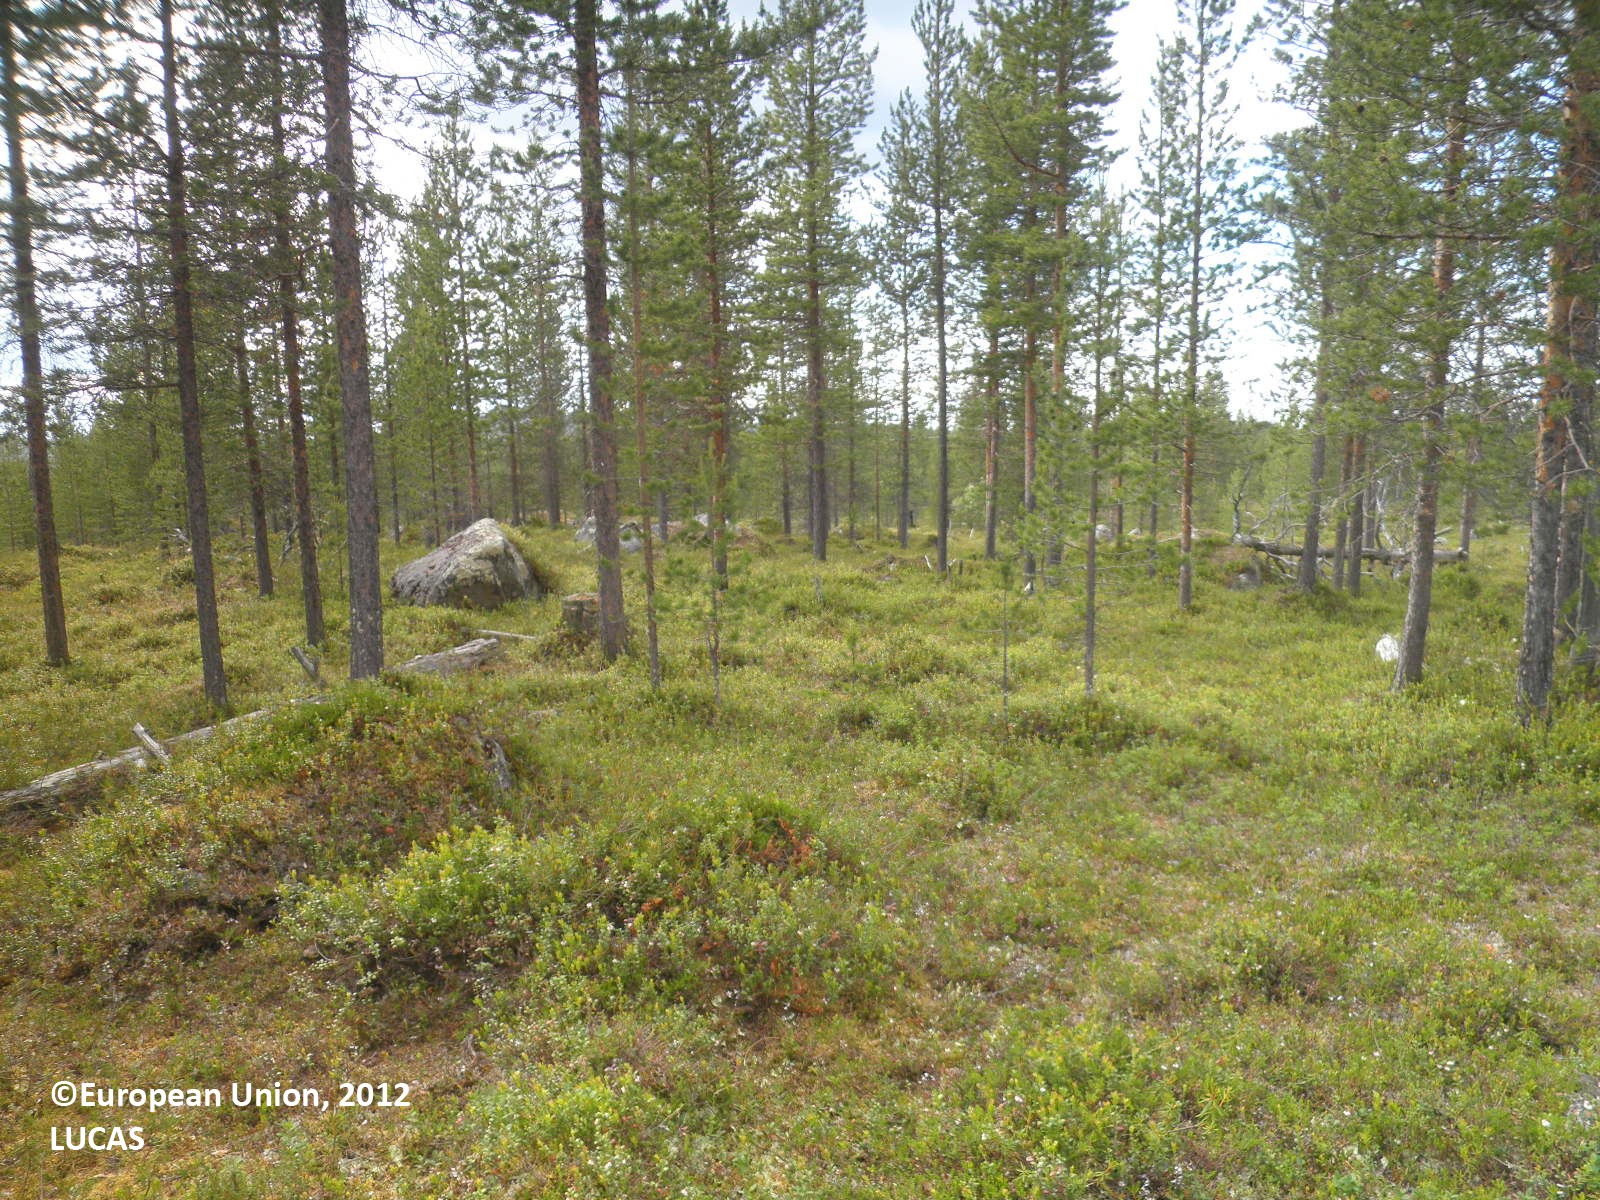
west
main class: Woodland
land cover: Pine dominated coniferous woodland
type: boreal forest
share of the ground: 25 - 50 %
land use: Forestry
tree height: > 5 m
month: July
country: FI
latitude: 68.6455
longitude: 27.8289
